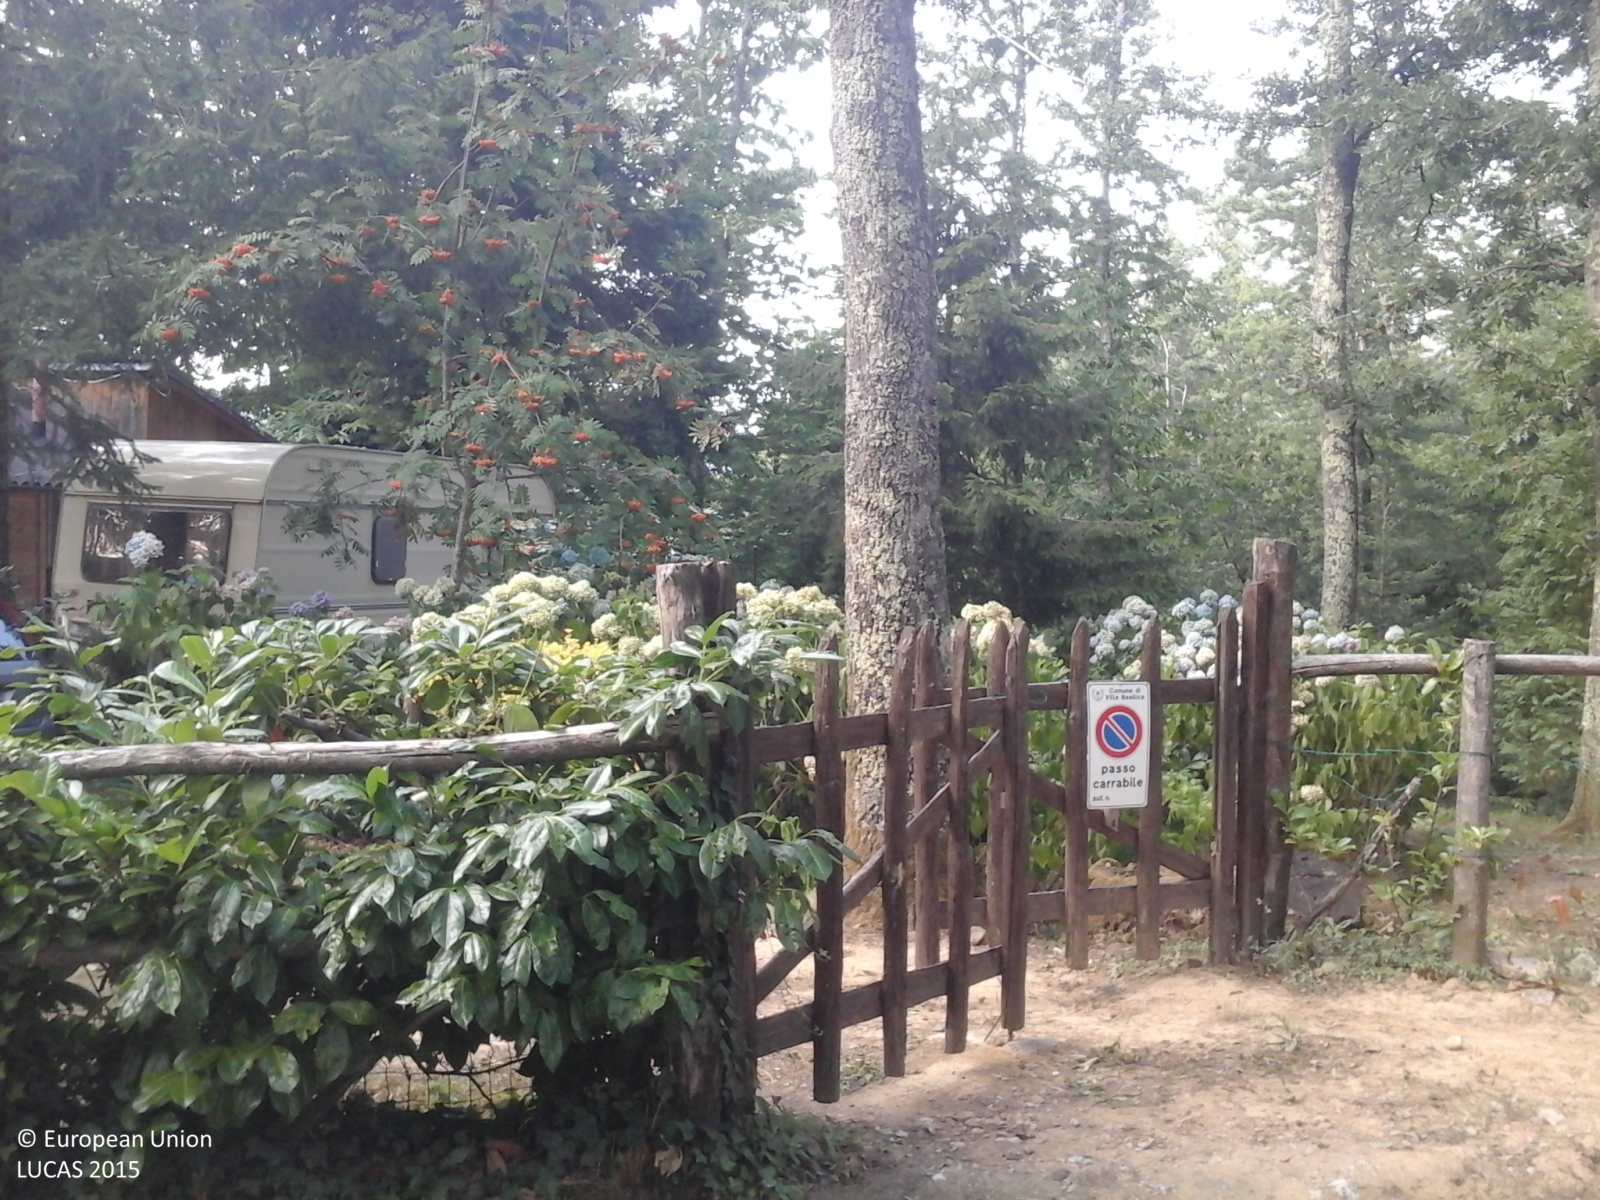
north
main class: Woodland
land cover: Broadleaved woodland
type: thermophilous deciduous forest
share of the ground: > 75 %
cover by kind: broadleaved forest trees 95 %, herbaceous plants 5 %
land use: Amenities, museums, leisure
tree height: > 5 m
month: August
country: IT
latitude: 43.9339
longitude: 10.6088
